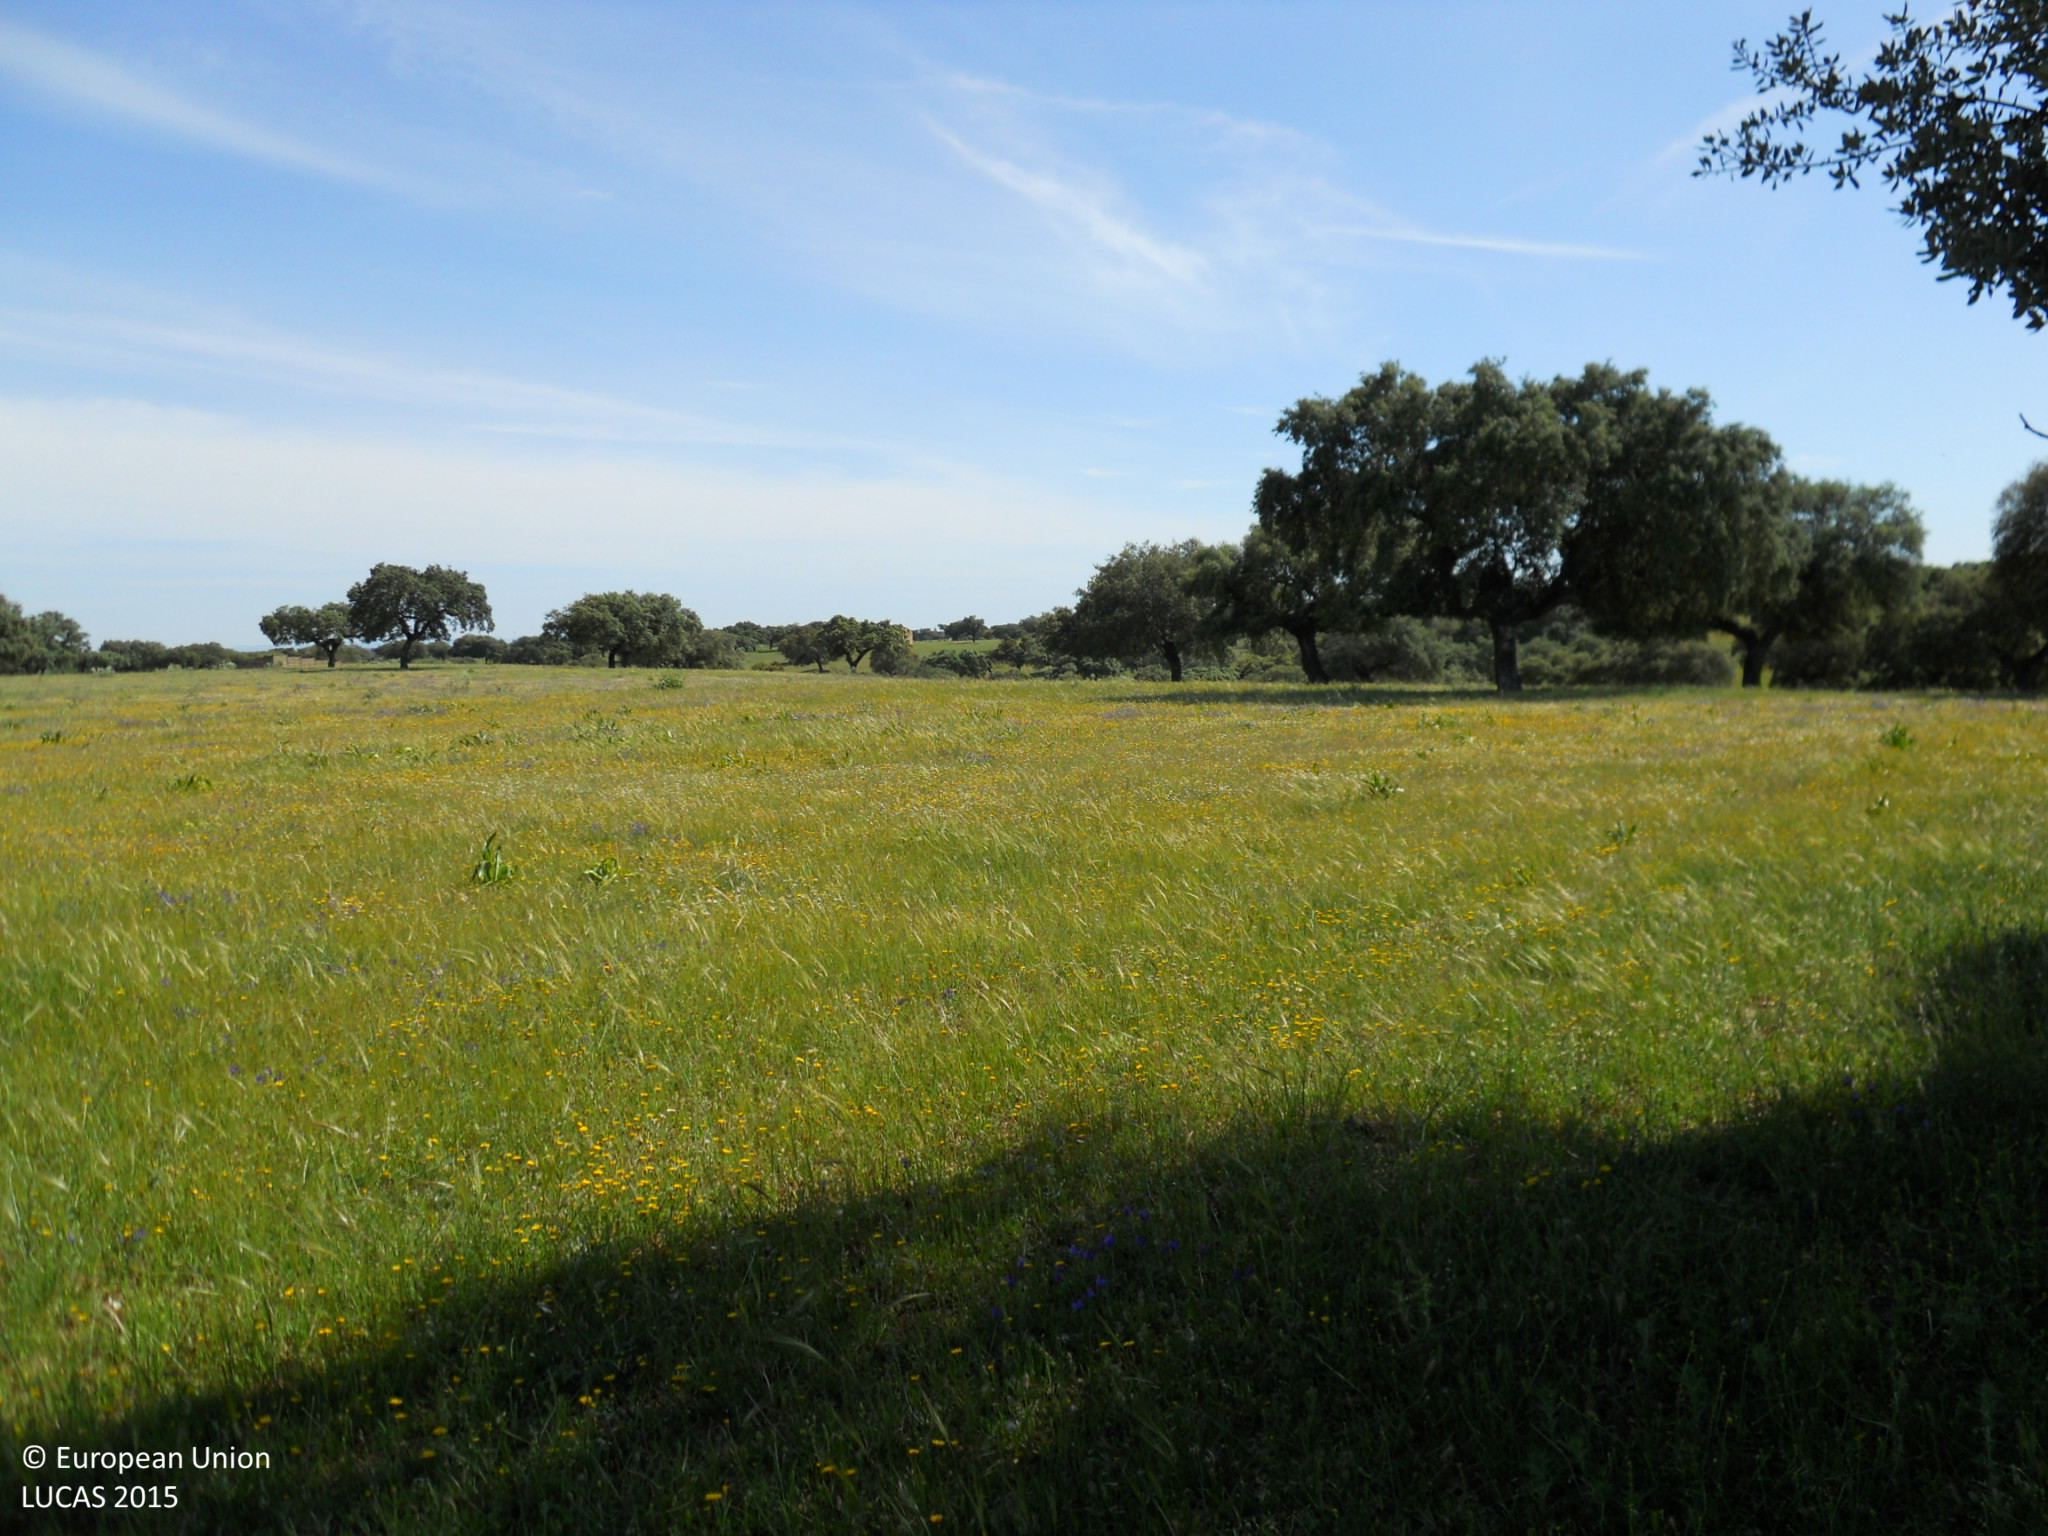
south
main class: Grassland
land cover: Grassland without tree/shrub cover
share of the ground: > 75 %
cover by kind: herbaceous plants 100 %
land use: Agriculture (excluding fallow land and kitchen gardens)
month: April
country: ES
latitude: 39.0031
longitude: -6.9419
